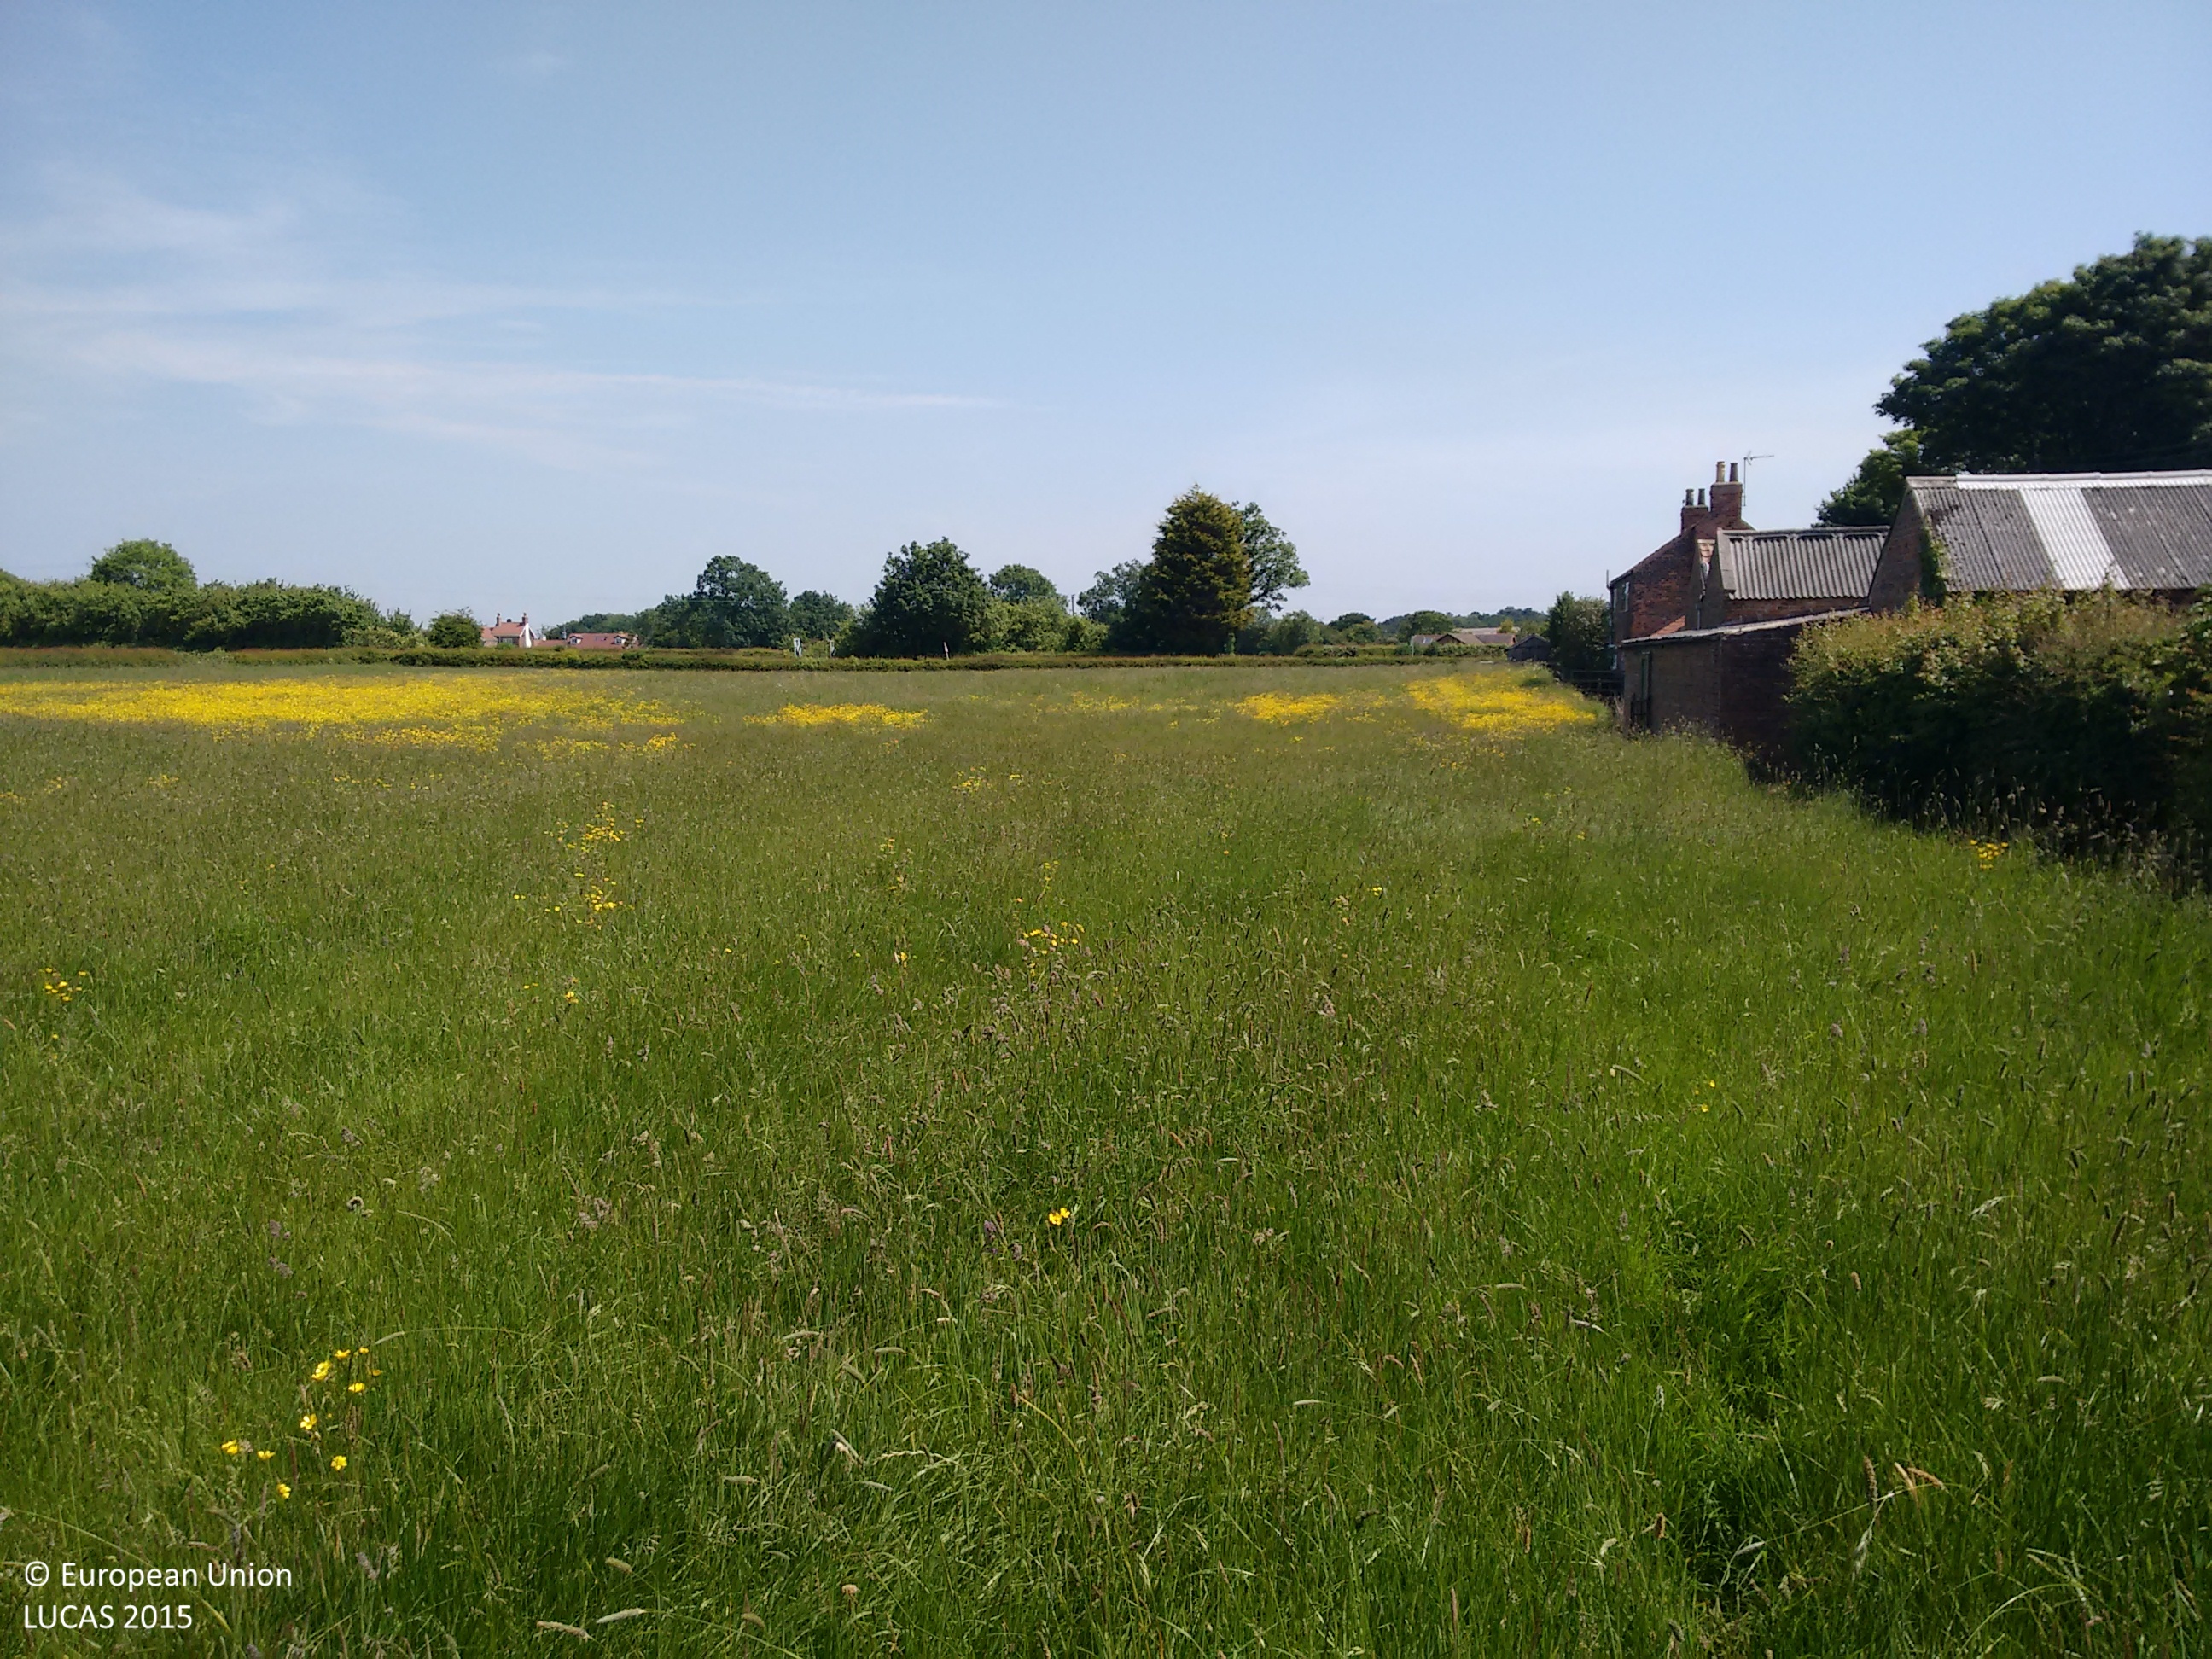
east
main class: Grassland
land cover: Grassland without tree/shrub cover
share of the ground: > 75 %
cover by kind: herbaceous plants 95 %, shrubs 5 %
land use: Agriculture (excluding fallow land and kitchen gardens)
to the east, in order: Grassland without tree/shrub cover; Managed hedges; Spontaneously vegetated surfaces; Managed hedges; Grass margins; Paved roads, cycling and walking lanes; Abandoned hedges; Managed hedges; Fences; Grassland without tree/shrub cover
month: June
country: GB
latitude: 53.8088
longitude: -1.1767
